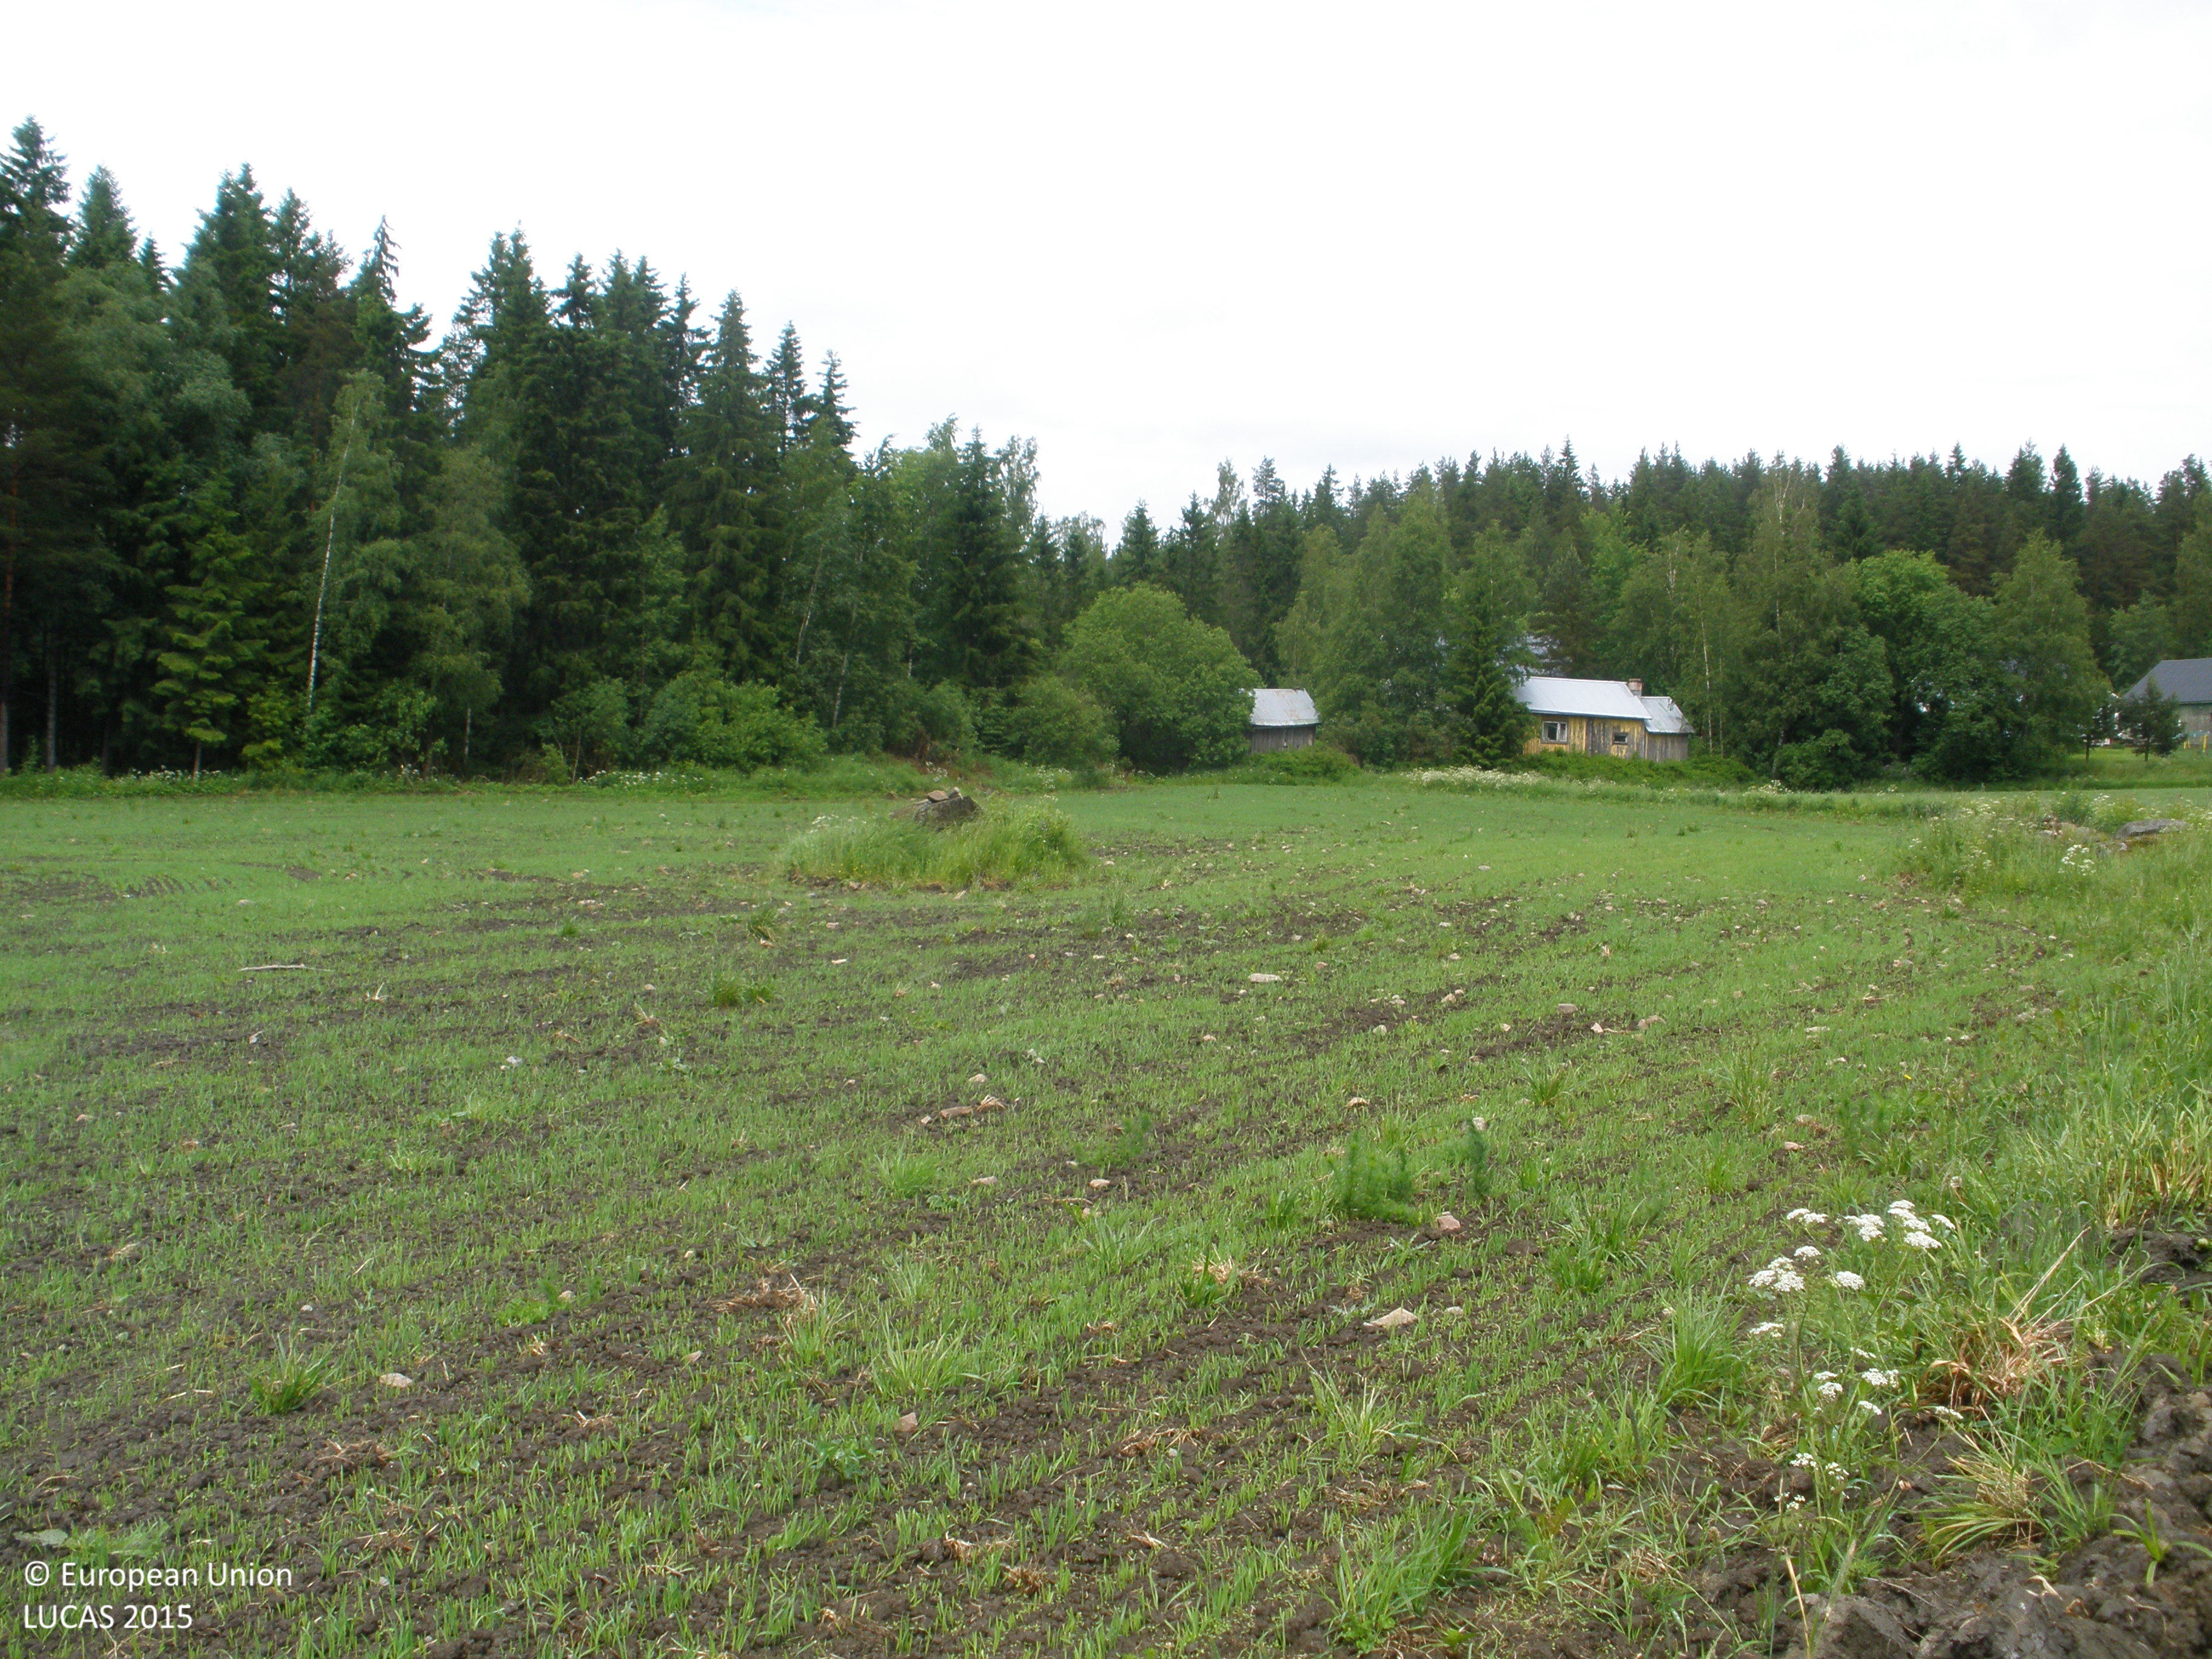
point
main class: Cropland
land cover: Oats
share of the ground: 25 - 50 %
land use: Agriculture (excluding fallow land and kitchen gardens)
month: June
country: FI
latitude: 60.8142
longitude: 23.4485
